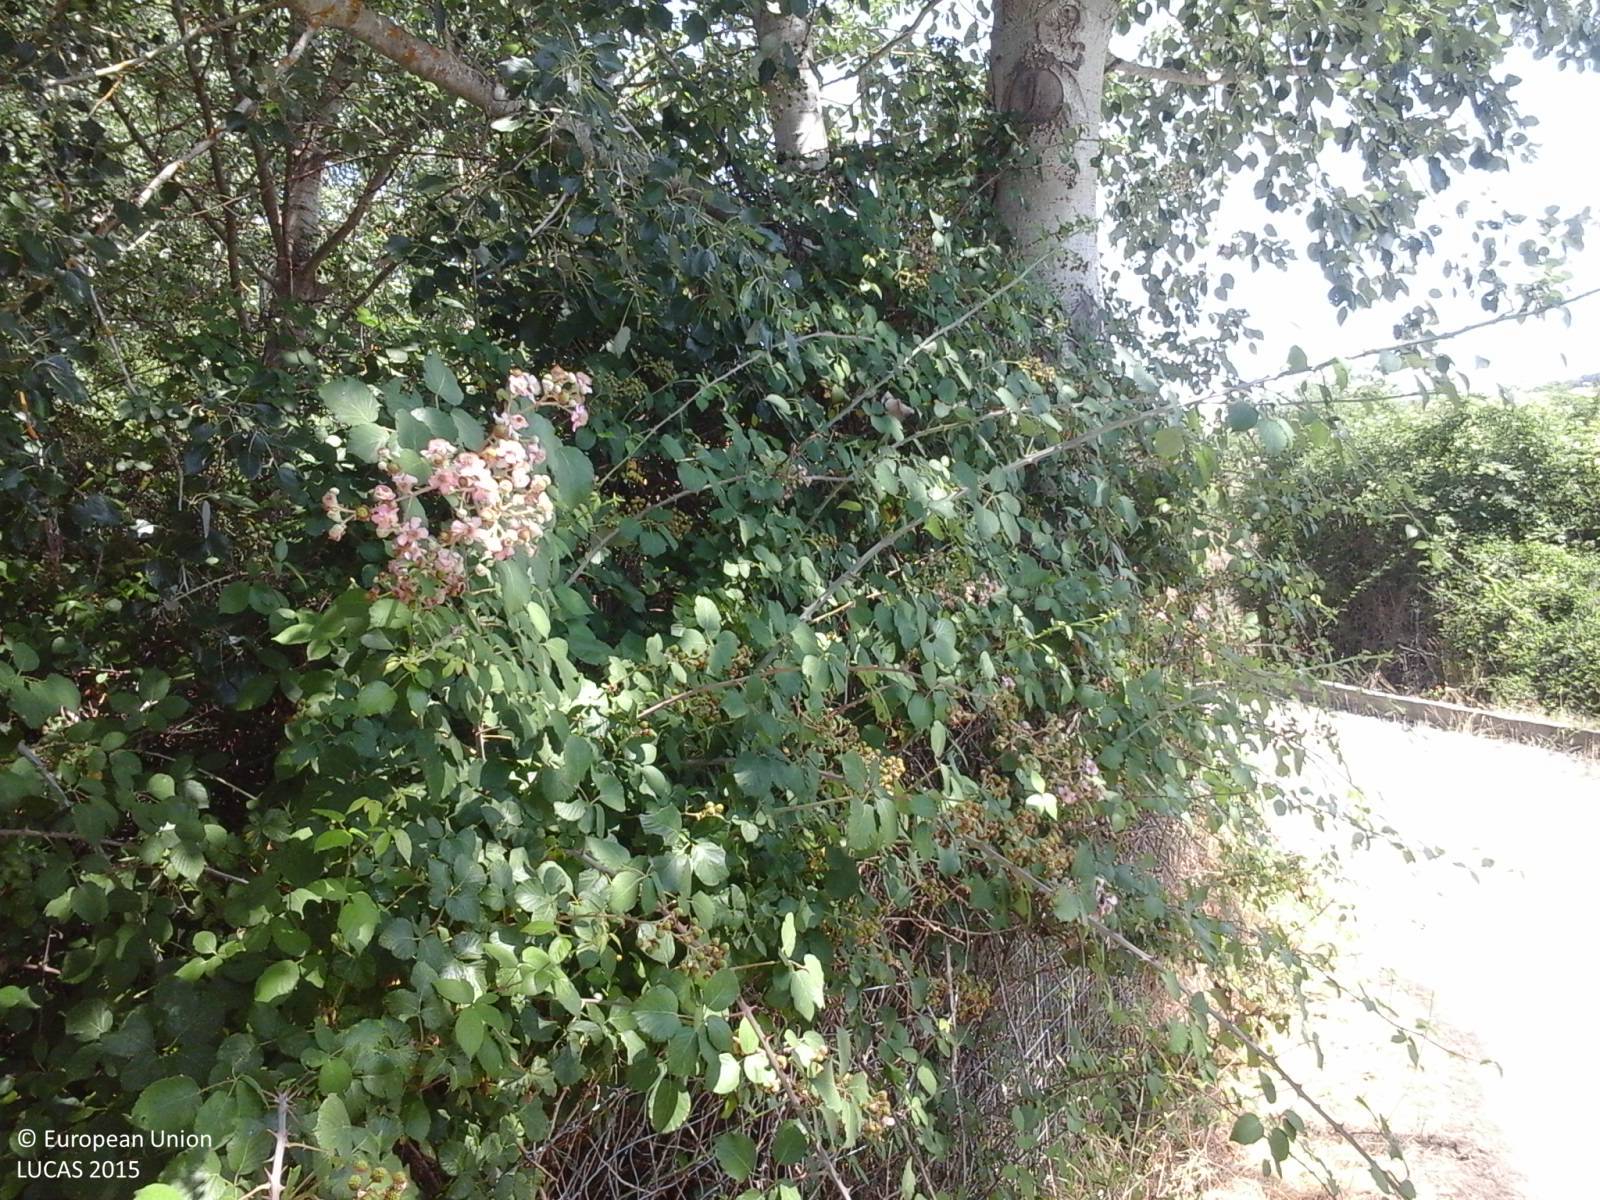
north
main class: Woodland
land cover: Broadleaved woodland
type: non-riverine alder, birch or aspen forest
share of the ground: 25 - 50 %
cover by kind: herbaceous plants 80 %, broadleaved forest trees 10 %, shrubs 5 %
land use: Semi-natural and natural areas not in use
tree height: > 5 m
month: July
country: IT
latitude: 40.4924
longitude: 8.5795
